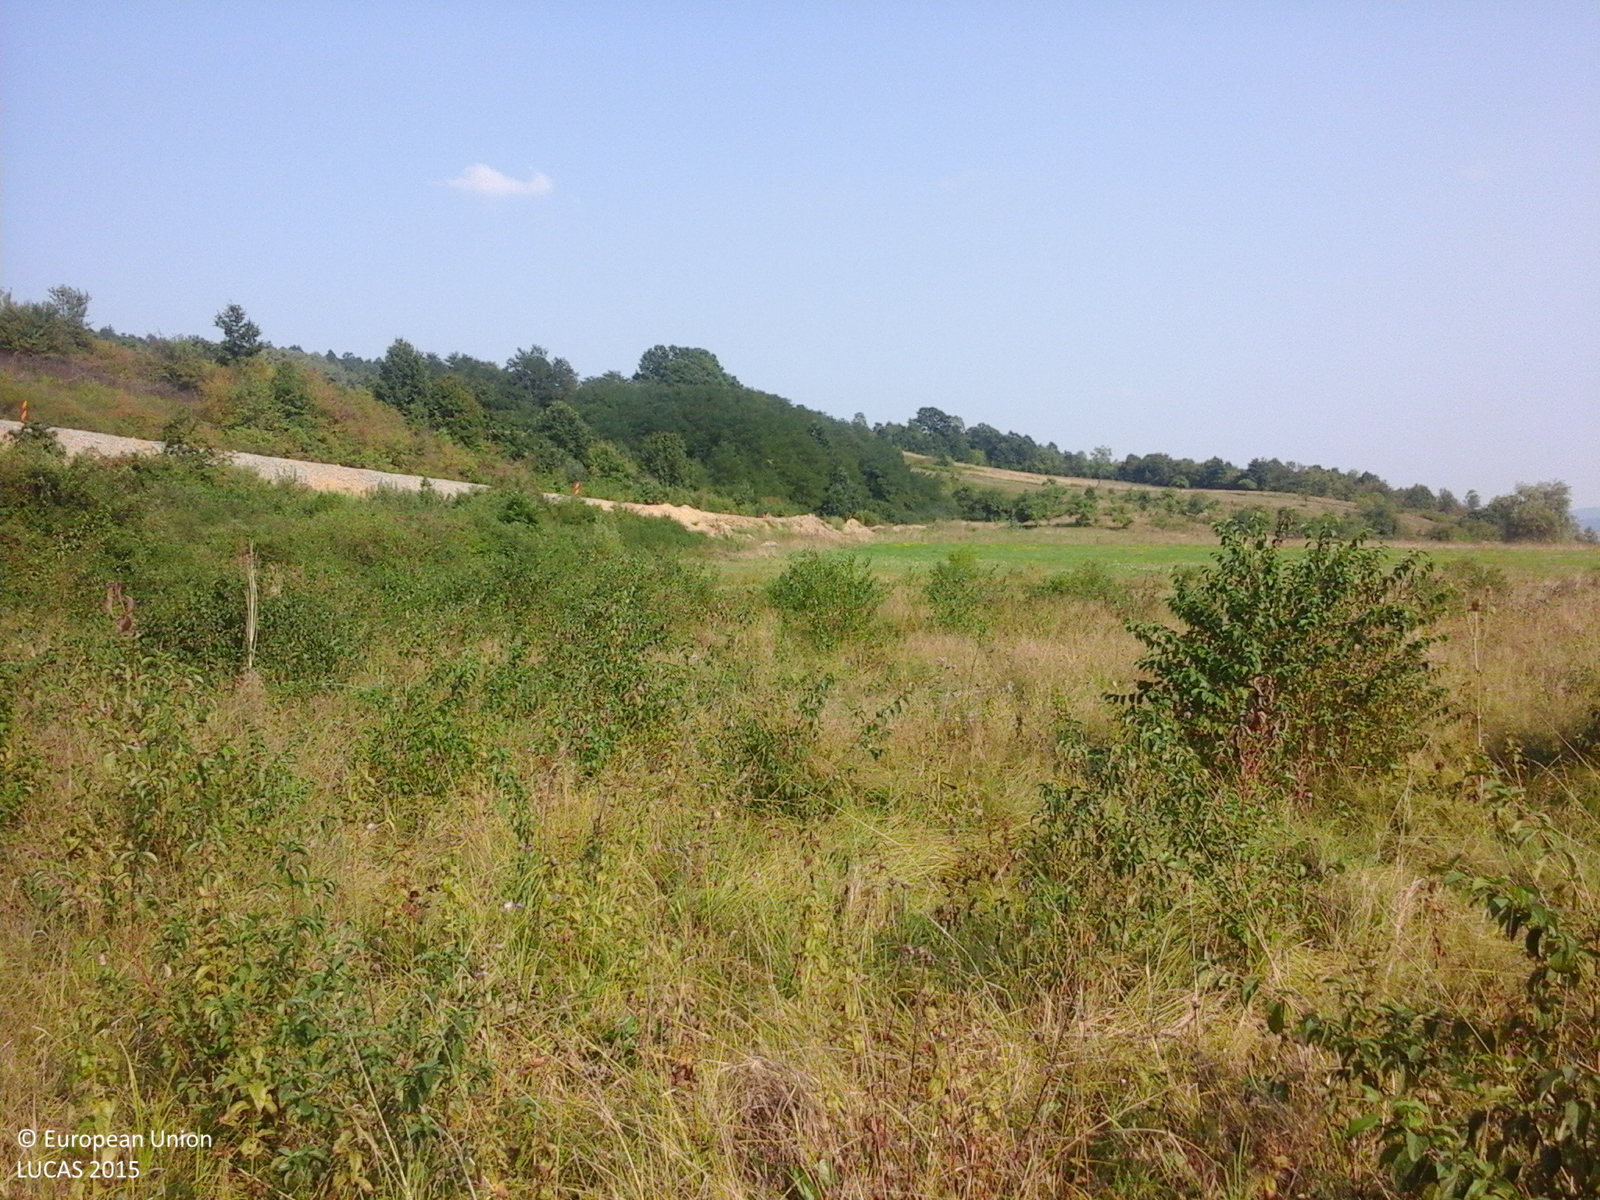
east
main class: Grassland
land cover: Spontaneously vegetated surfaces
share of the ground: > 75 %
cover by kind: herbaceous plants 100 %
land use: Fallow land
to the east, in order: Spontaneously vegetated surfaces; Grassland without tree/shrub cover; Shrubland without tree cover; Ditches and canals; Paved roads, cycling and walking lanes; Ditches and canals; Shrubland with sparse tree cover; Grassland without tree/shrub cover; Lines of trees; Grassland without tree/shrub cover; Shrubland with sparse tree cover; Grassland without tree/shrub cover
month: August
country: RO
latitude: 46.2059
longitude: 22.5839
